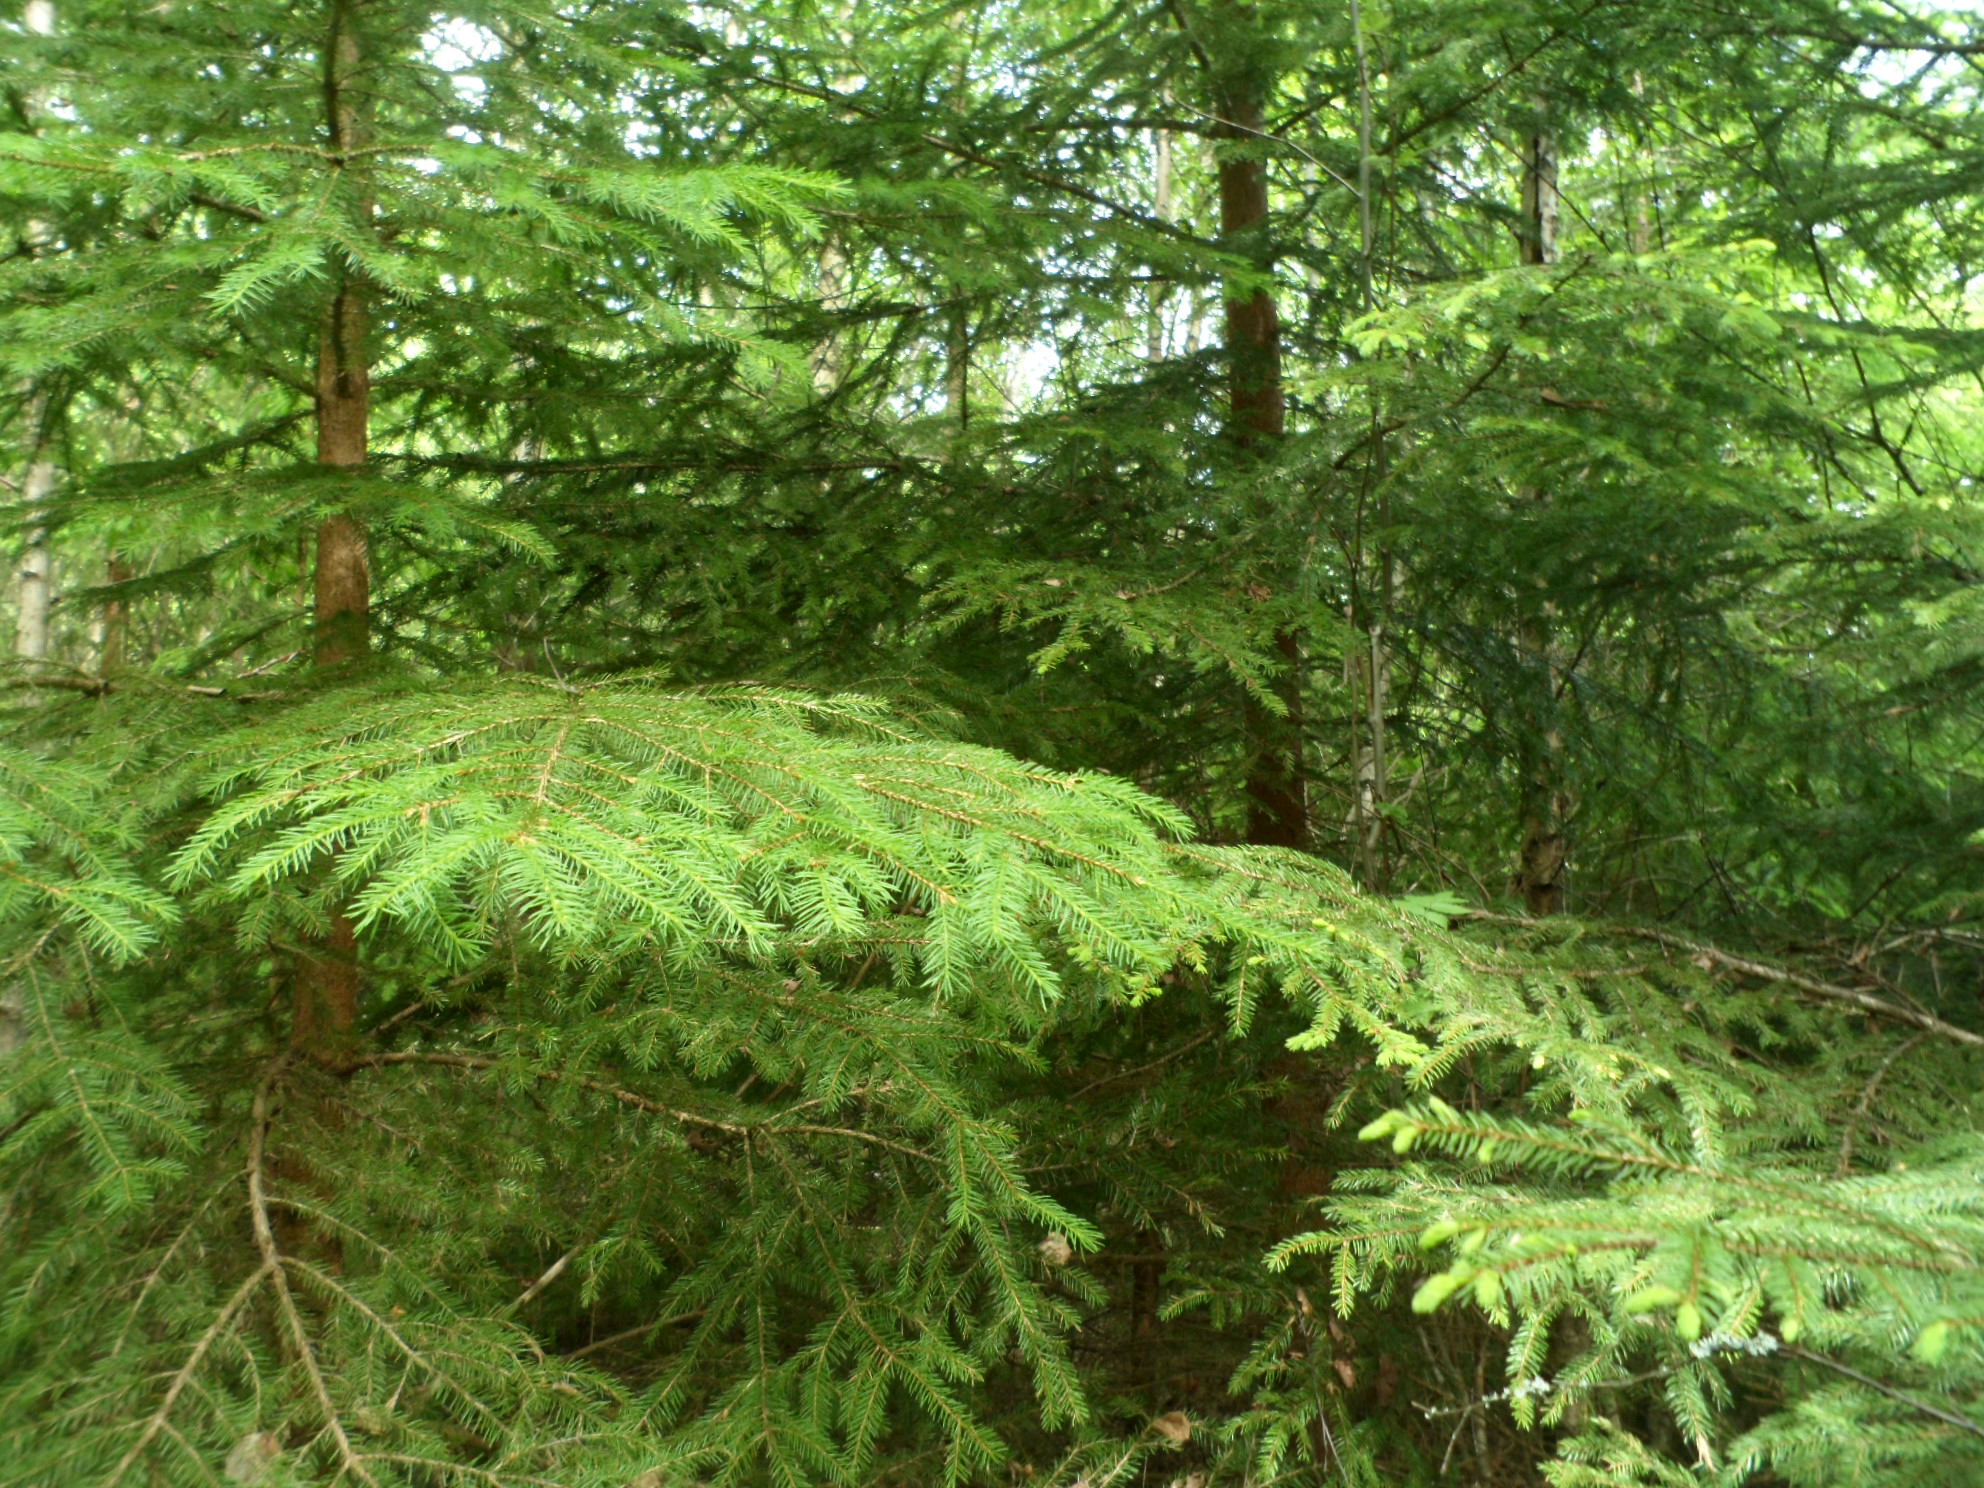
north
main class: Woodland
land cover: Spruce dominated mixed woodland
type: boreal forest
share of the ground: > 75 %
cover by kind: coniferous forest trees 40 %, broadleaved forest trees 35 %, lichens and mosses 15 %, herbaceous plants 5 %, unconsolidated bare surface 5 %
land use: Forestry
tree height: > 5 m
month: June
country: SE
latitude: 56.9789
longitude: 15.3121
